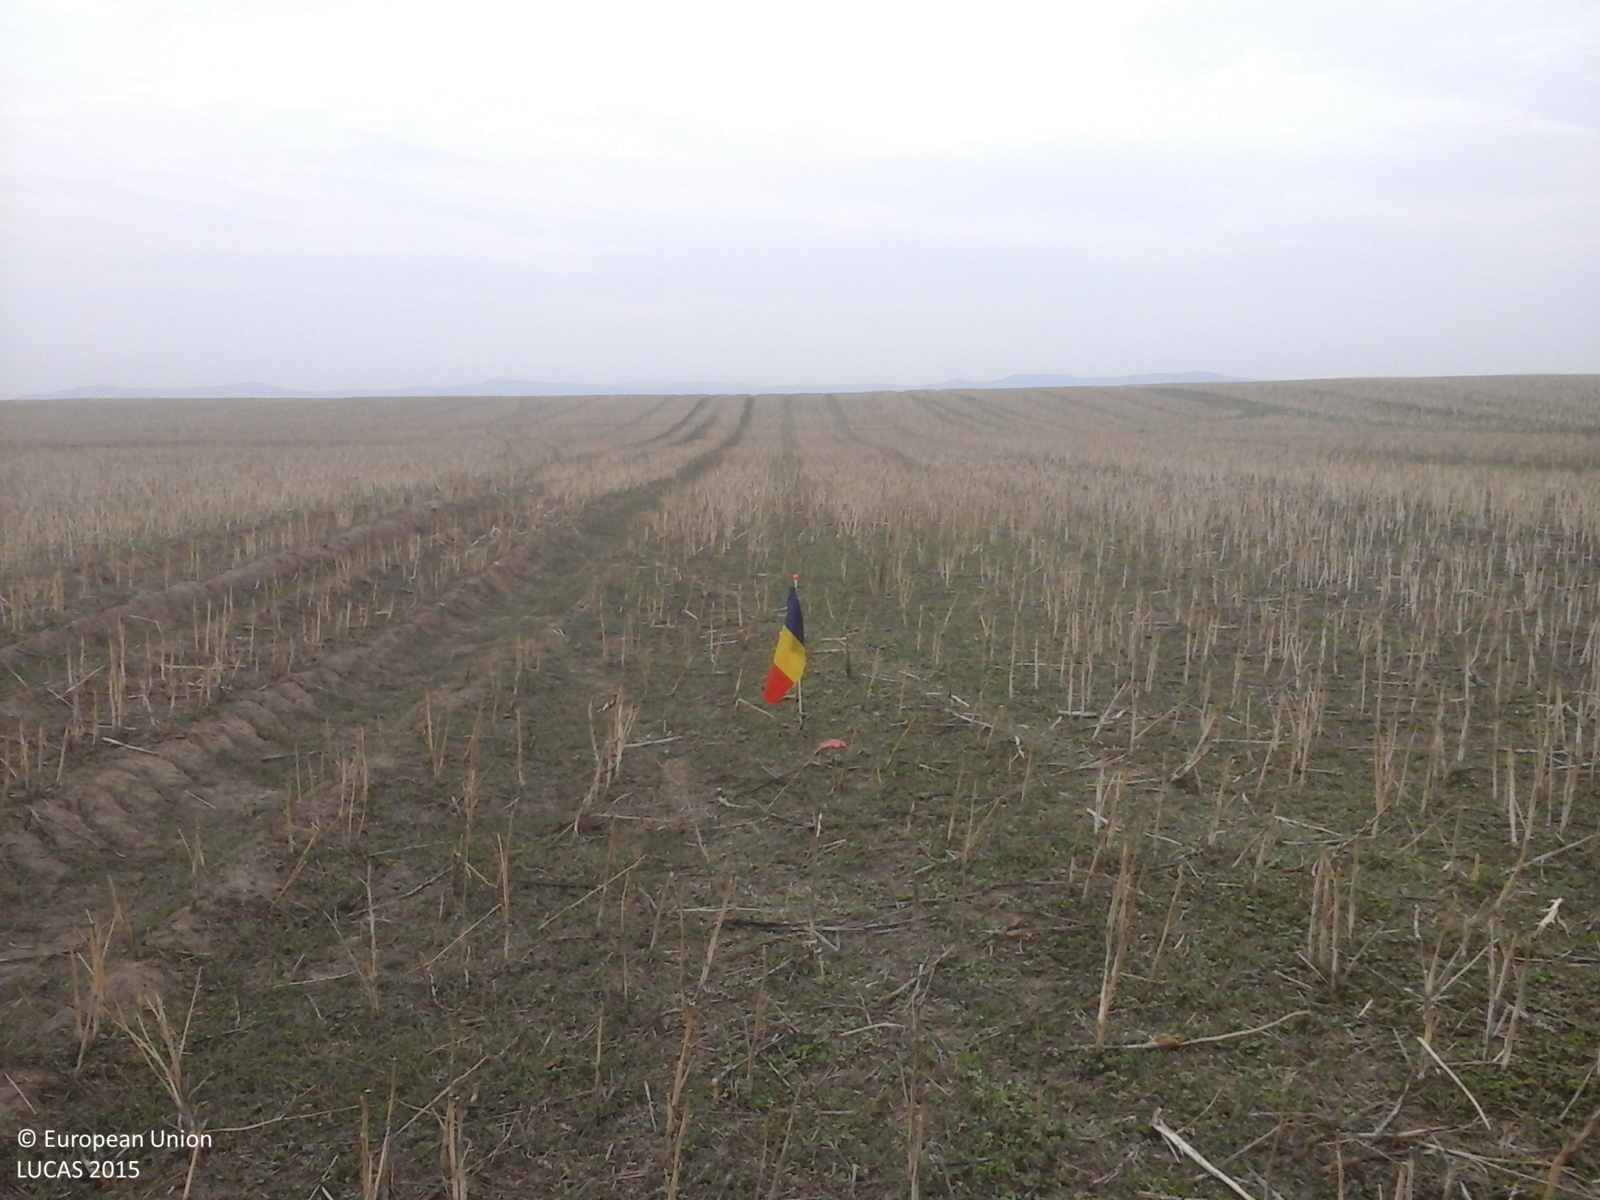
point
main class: Cropland
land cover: Rape and turnip rape
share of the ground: 10 - 25 %
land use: Agriculture (excluding fallow land and kitchen gardens)
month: August
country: RO
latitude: 46.2270
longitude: 21.4322
